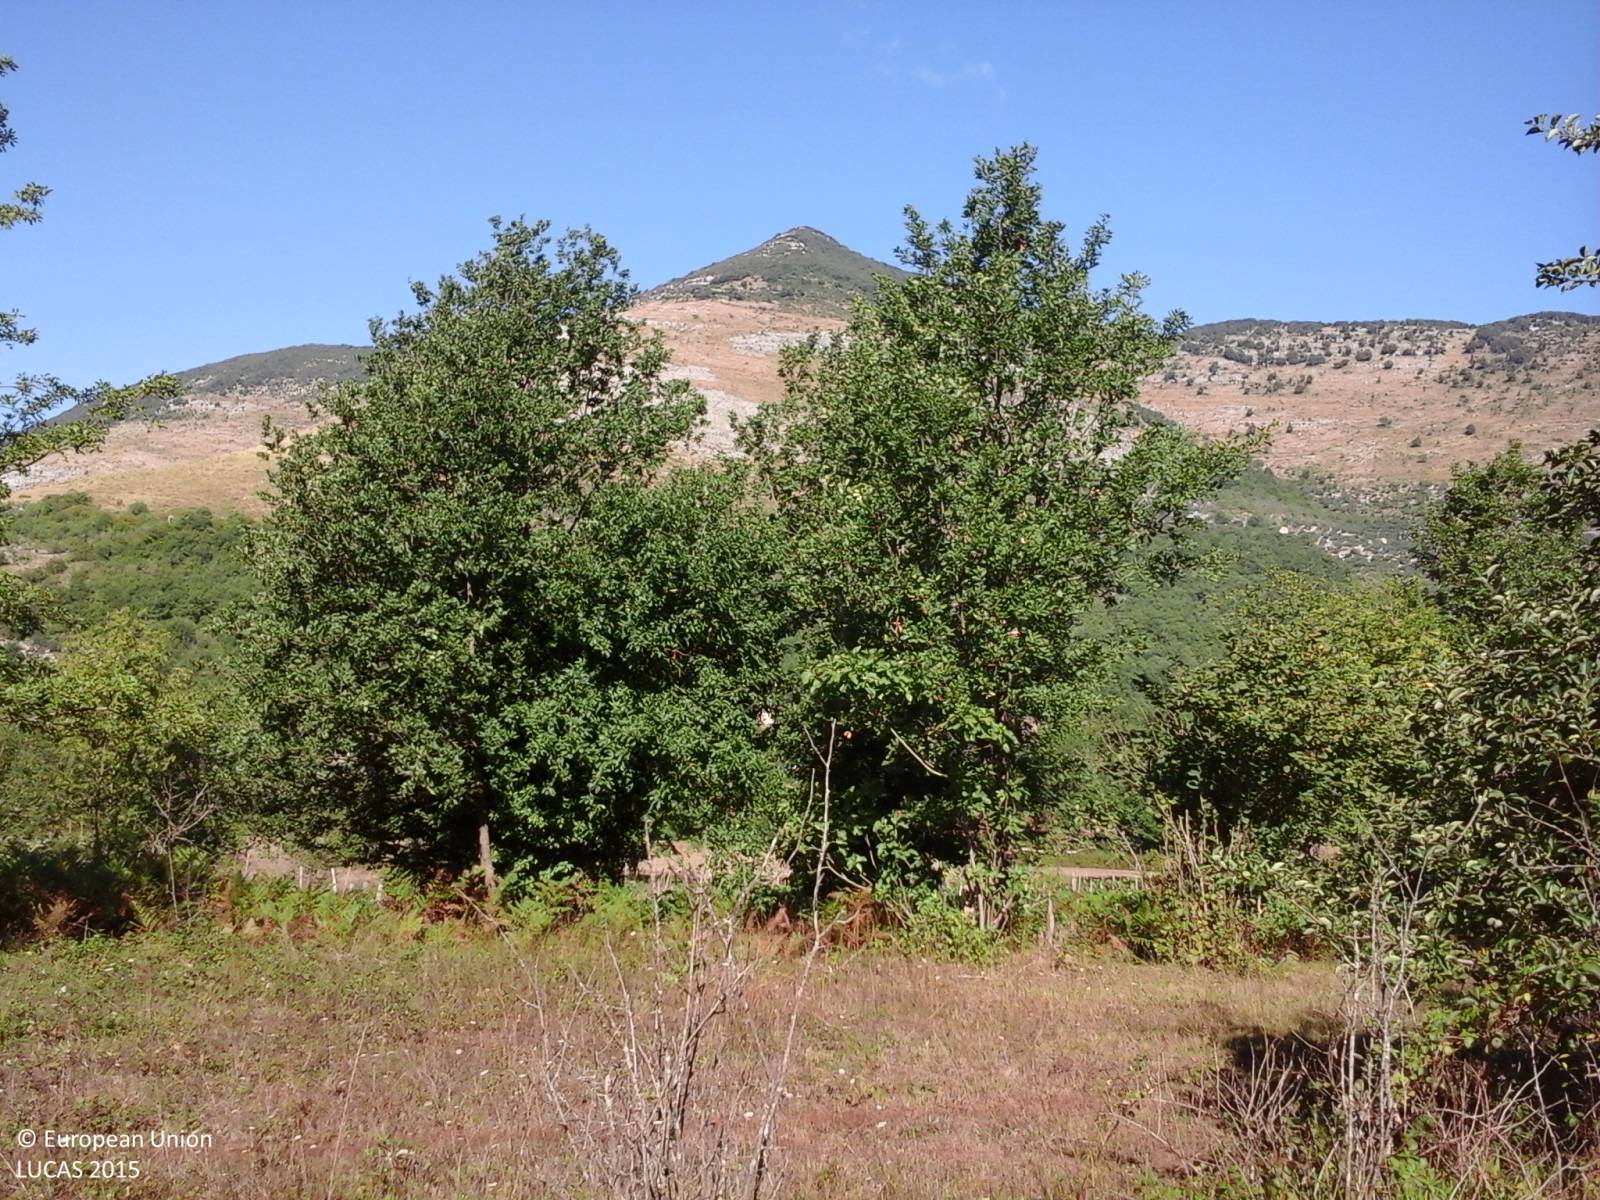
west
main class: Grassland
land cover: Grassland without tree/shrub cover
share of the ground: > 75 %
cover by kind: herbaceous plants 100 %
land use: Agriculture (excluding fallow land and kitchen gardens)
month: August
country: IT
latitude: 41.4216
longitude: 13.3967
